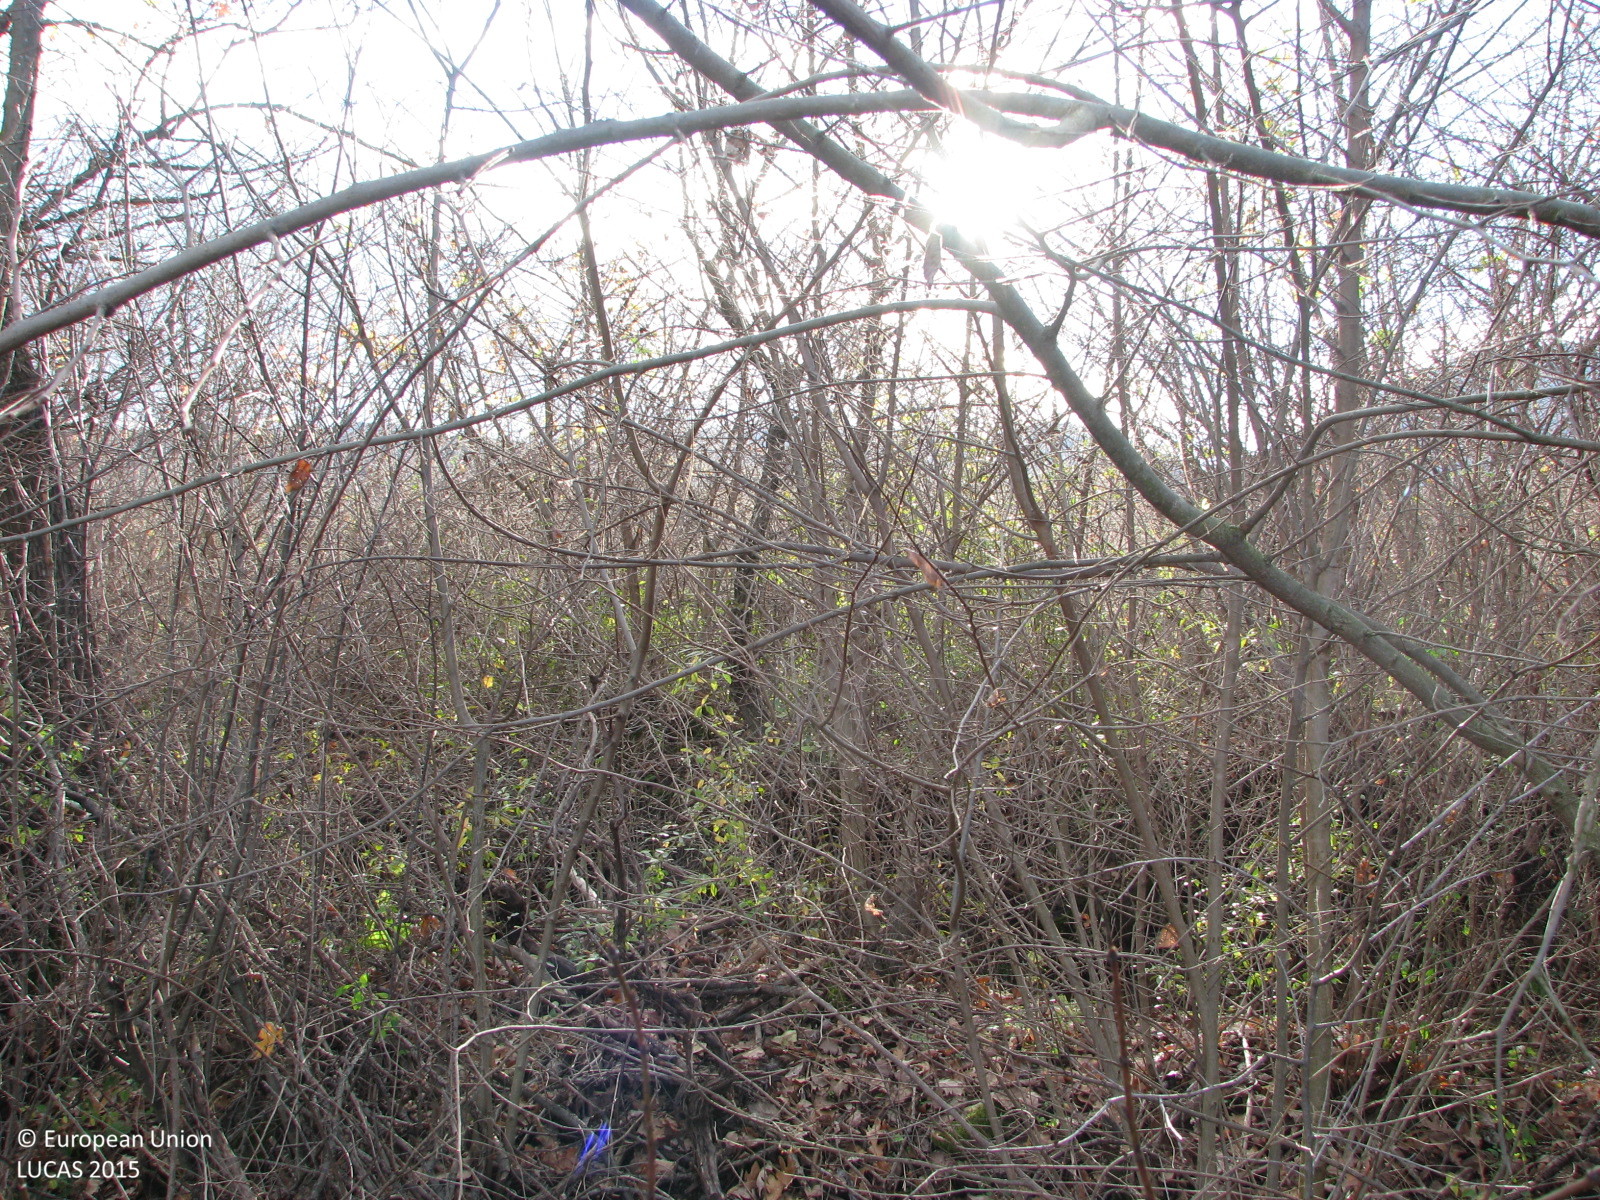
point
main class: Shrubland
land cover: Shrubland with sparse tree cover
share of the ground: > 75 %
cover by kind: shrubs 90 %, broadleaved forest trees 5 %, herbaceous plants 5 %
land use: Abandoned areas
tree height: < 5 m
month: November
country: BG
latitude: 42.5771
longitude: 24.7373
